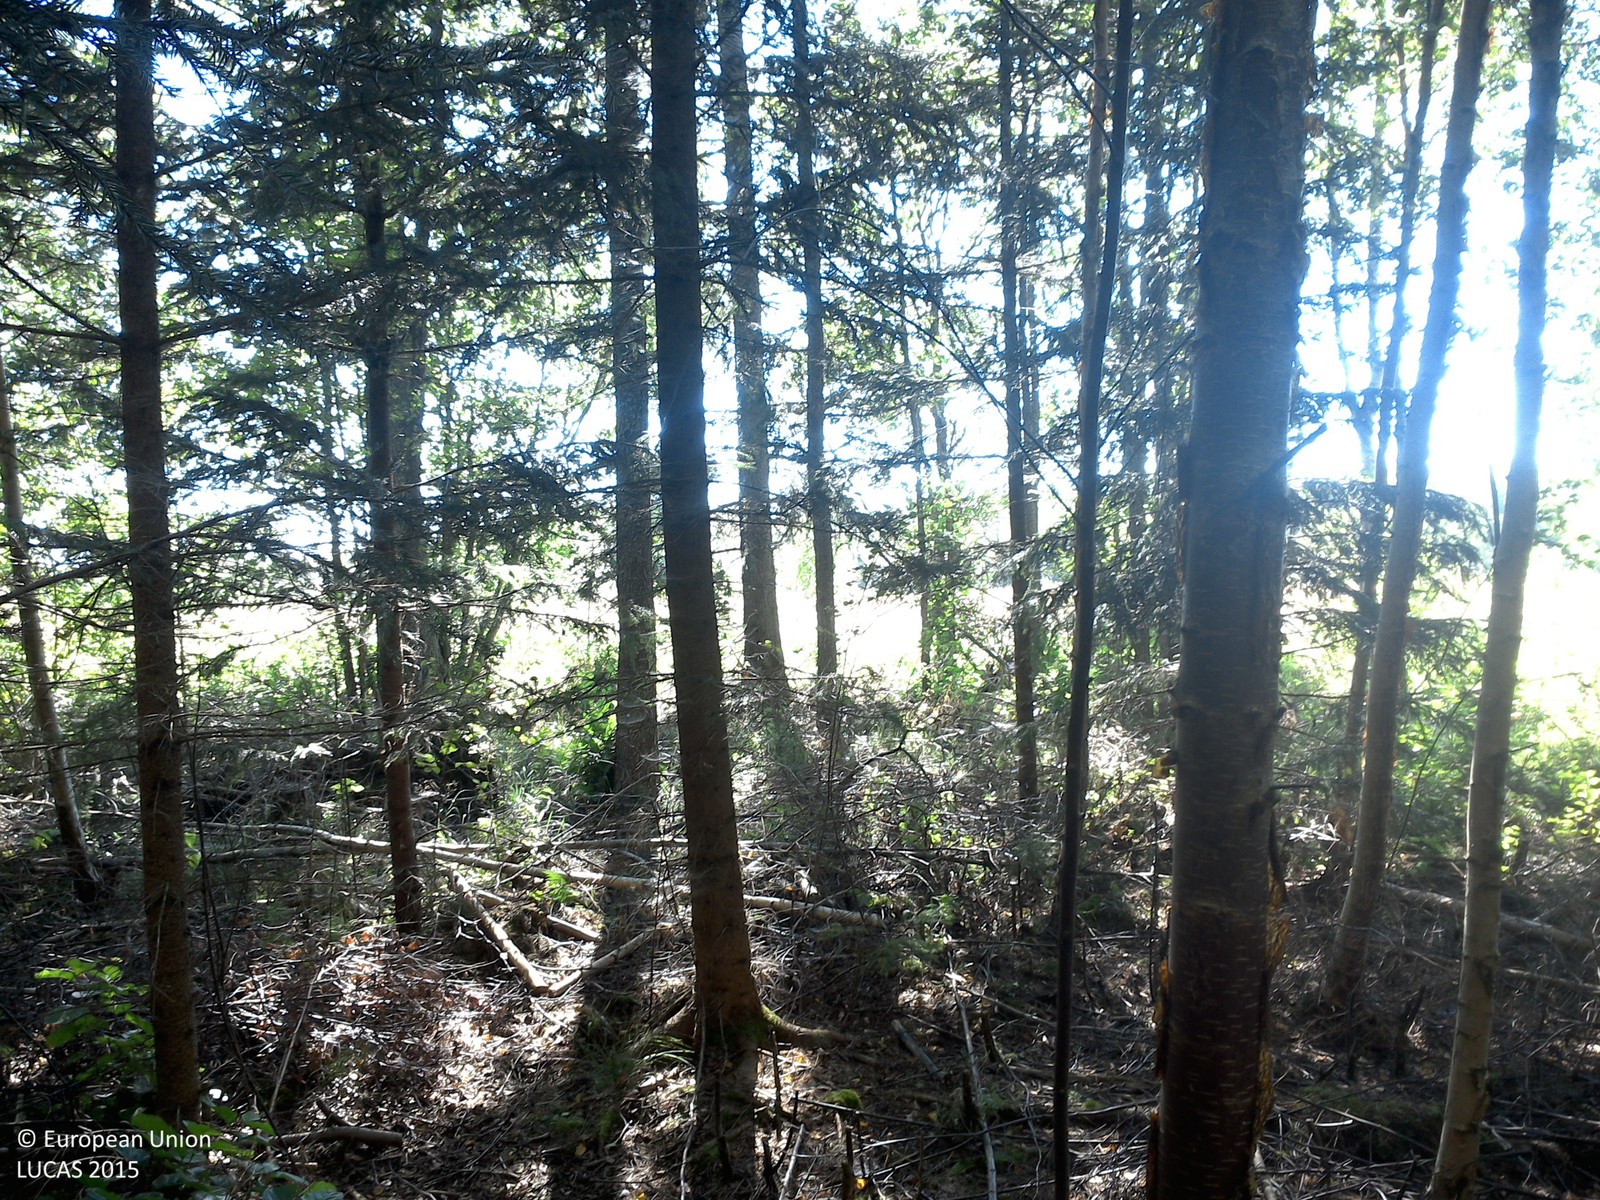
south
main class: Woodland
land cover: Spruce dominated mixed woodland
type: boreal forest
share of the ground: > 75 %
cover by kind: coniferous forest trees 55 %, broadleaved forest trees 20 %, lichens and mosses 15 %, herbaceous plants 10 %
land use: Forestry
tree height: > 5 m
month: August
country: SE
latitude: 57.9673
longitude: 15.3878
